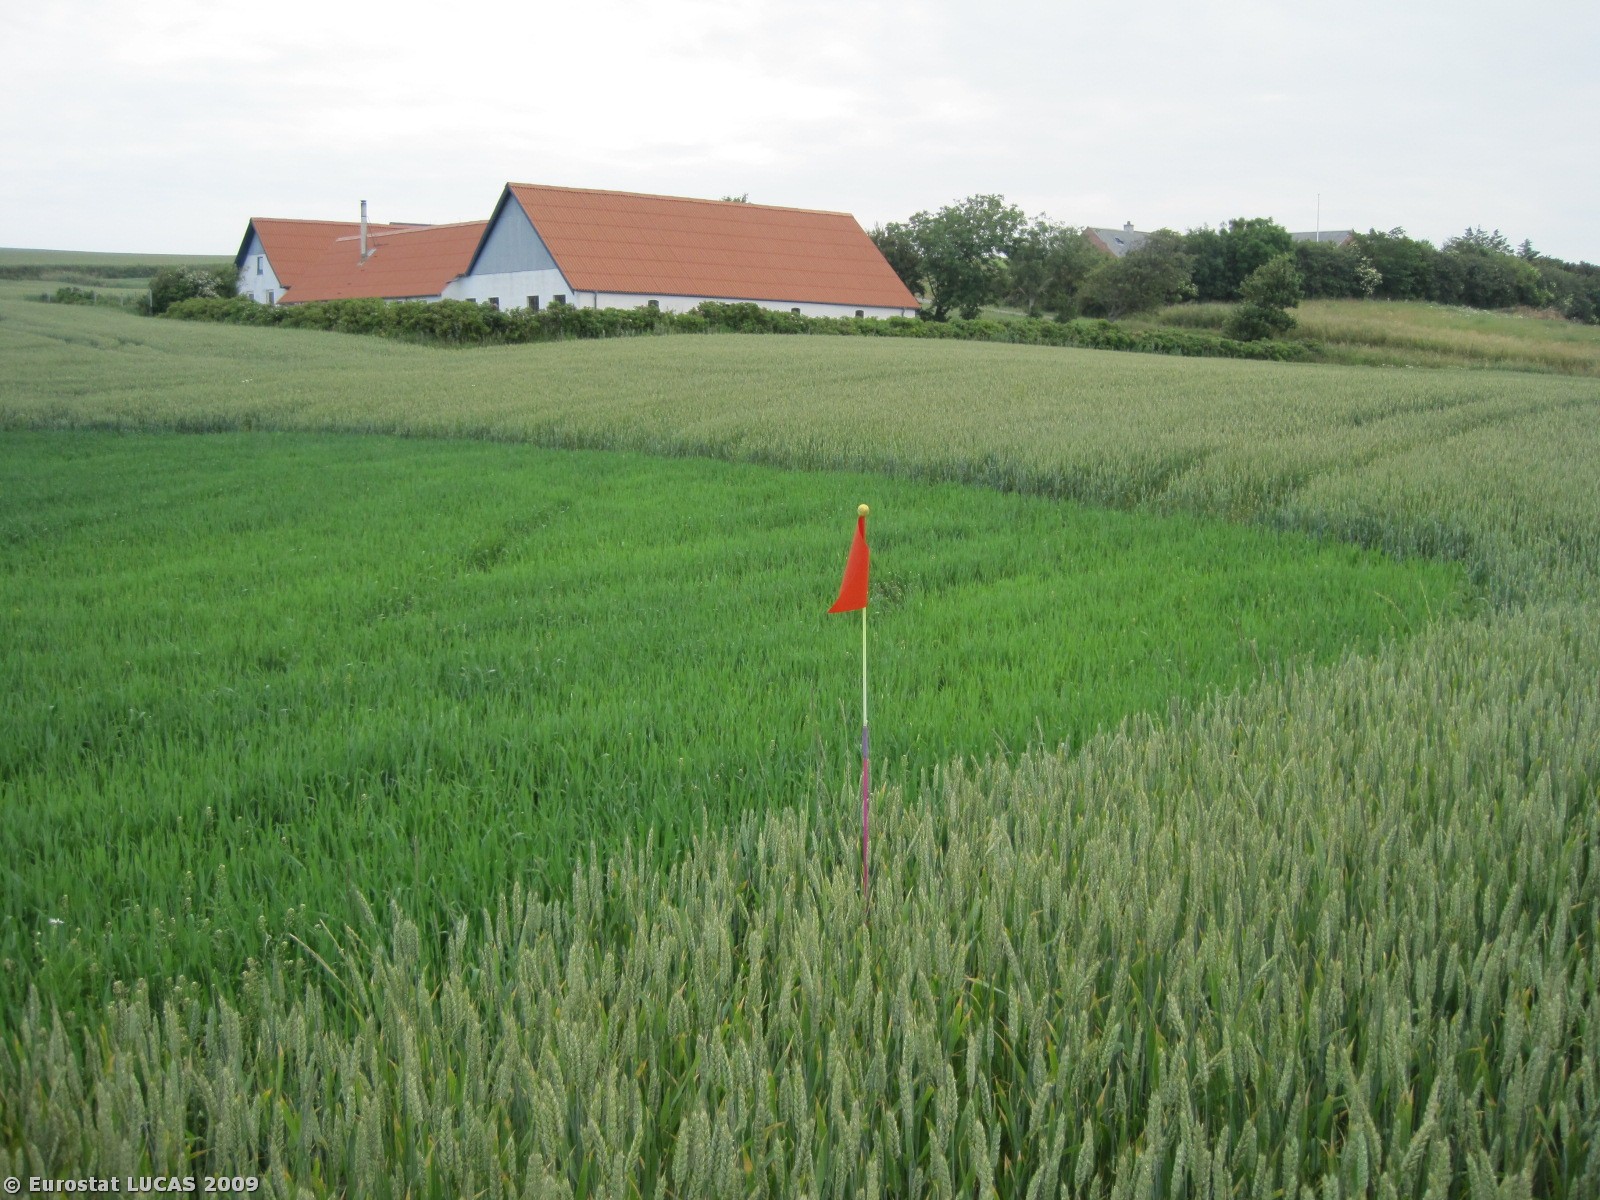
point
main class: Cropland
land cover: Common wheat
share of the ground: > 75 %
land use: Agriculture (excluding fallow land and kitchen gardens)
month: June
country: DK
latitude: 56.5549
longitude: 8.3589
